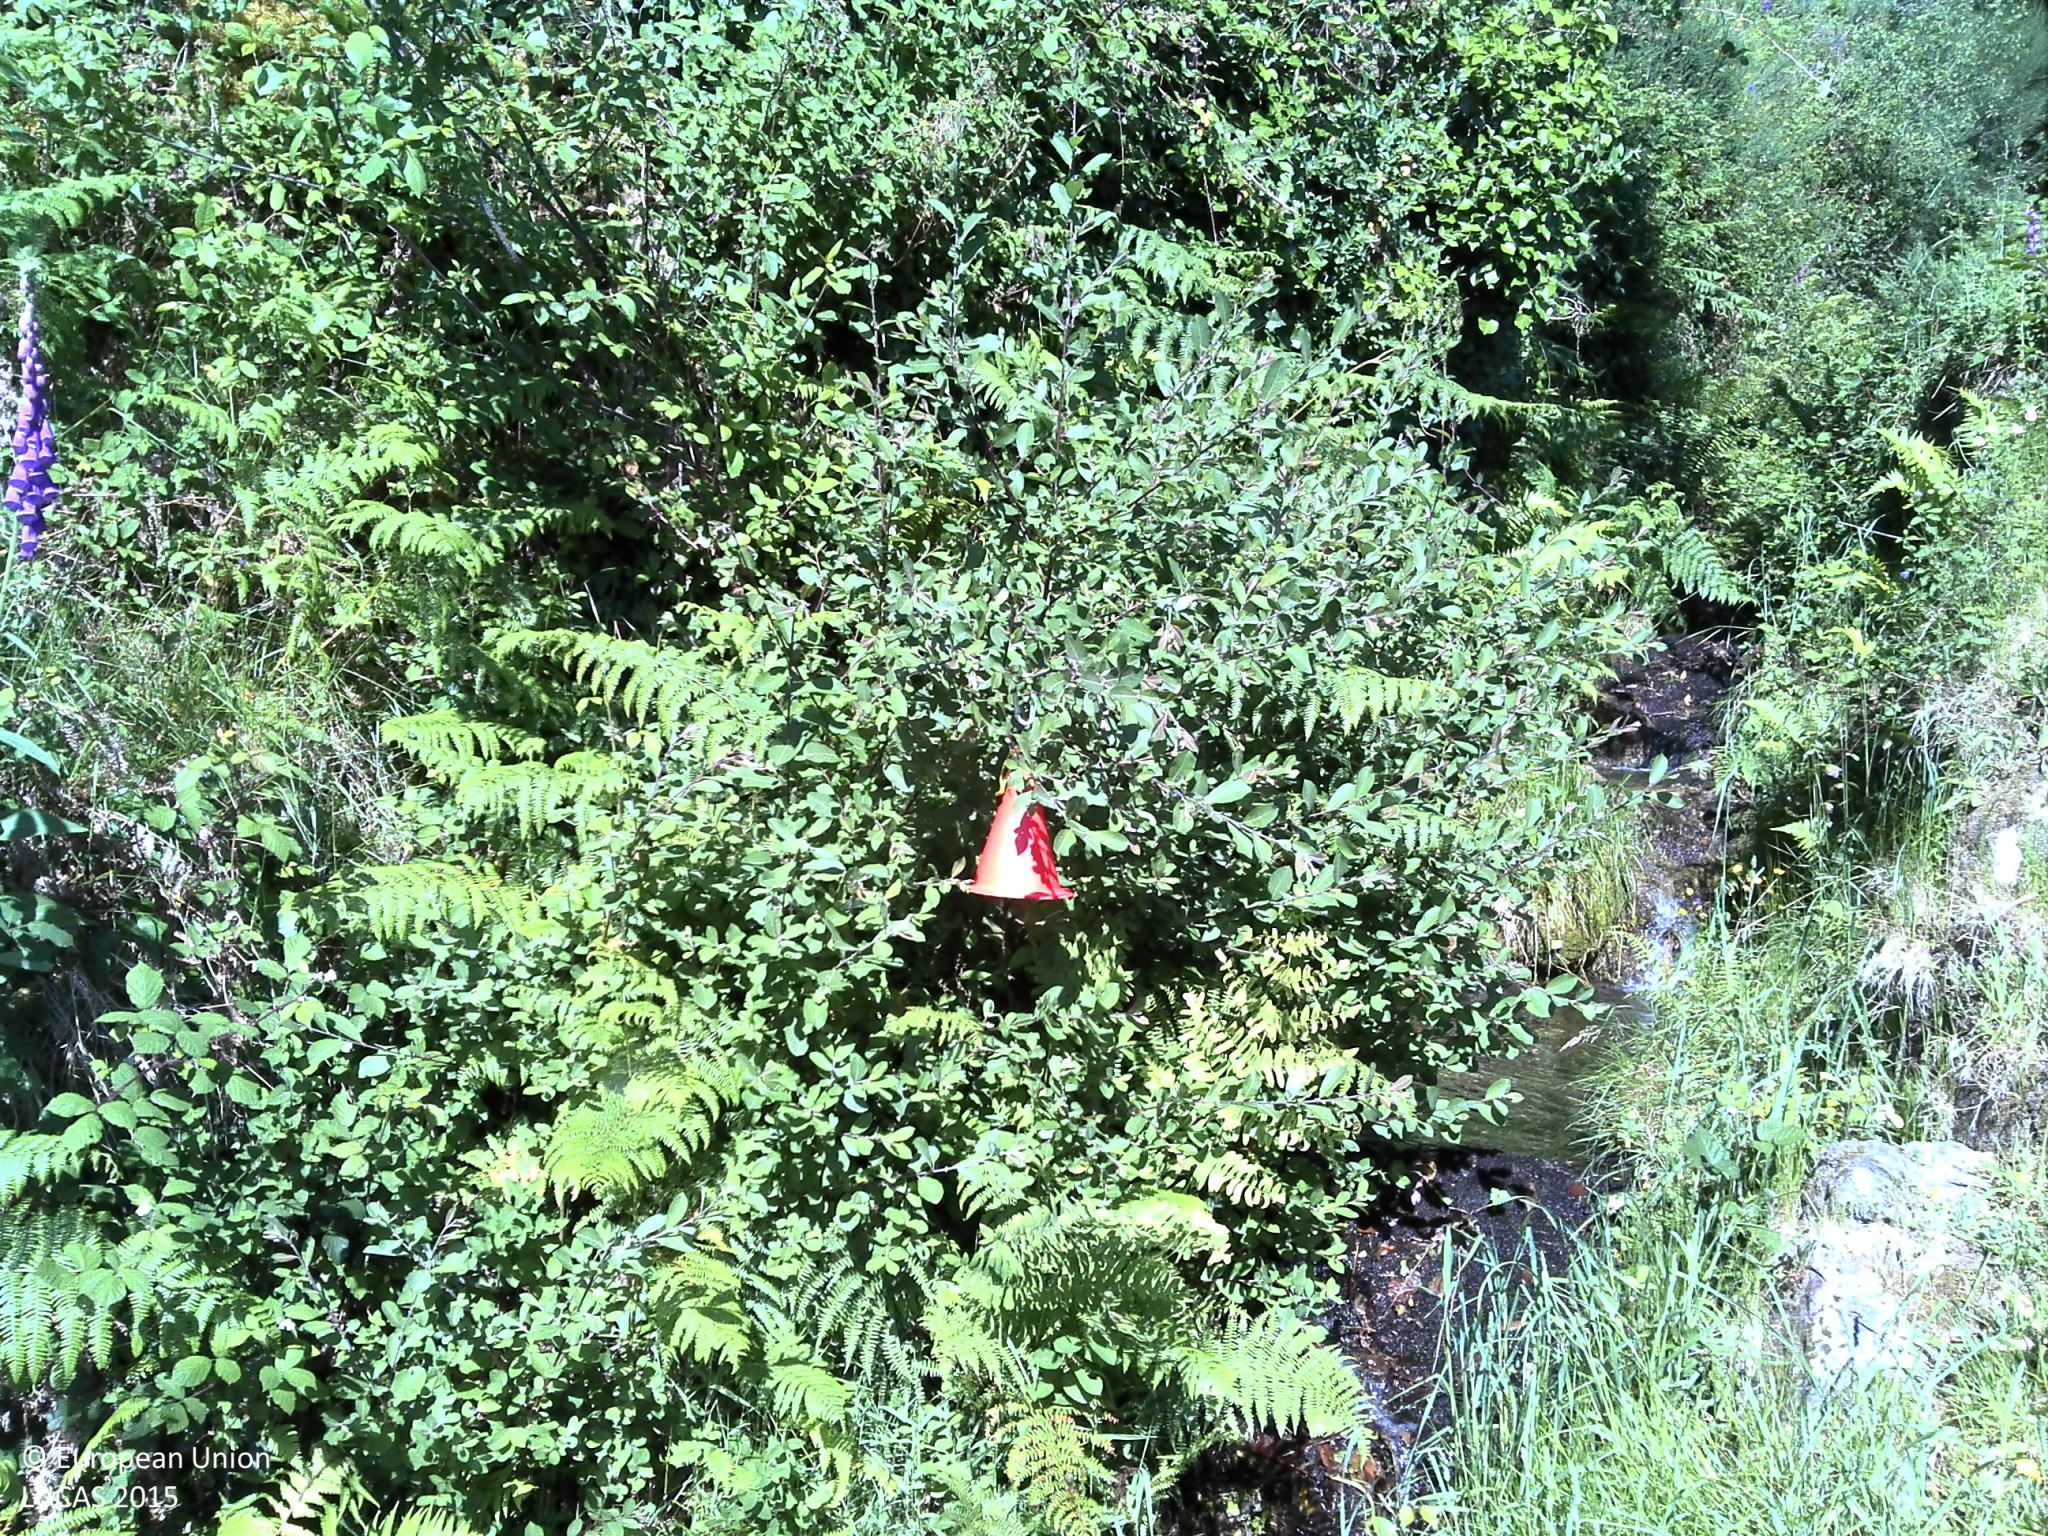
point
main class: Shrubland
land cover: Shrubland with sparse tree cover
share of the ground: 50 - 75 %
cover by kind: shrubs 60 %, unconsolidated bare surface 20 %, herbaceous plants 15 %, broadleaved forest trees 5 %
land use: Semi-natural and natural areas not in use
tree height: > 5 m
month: May
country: PT
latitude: 41.9112
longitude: -8.6982
